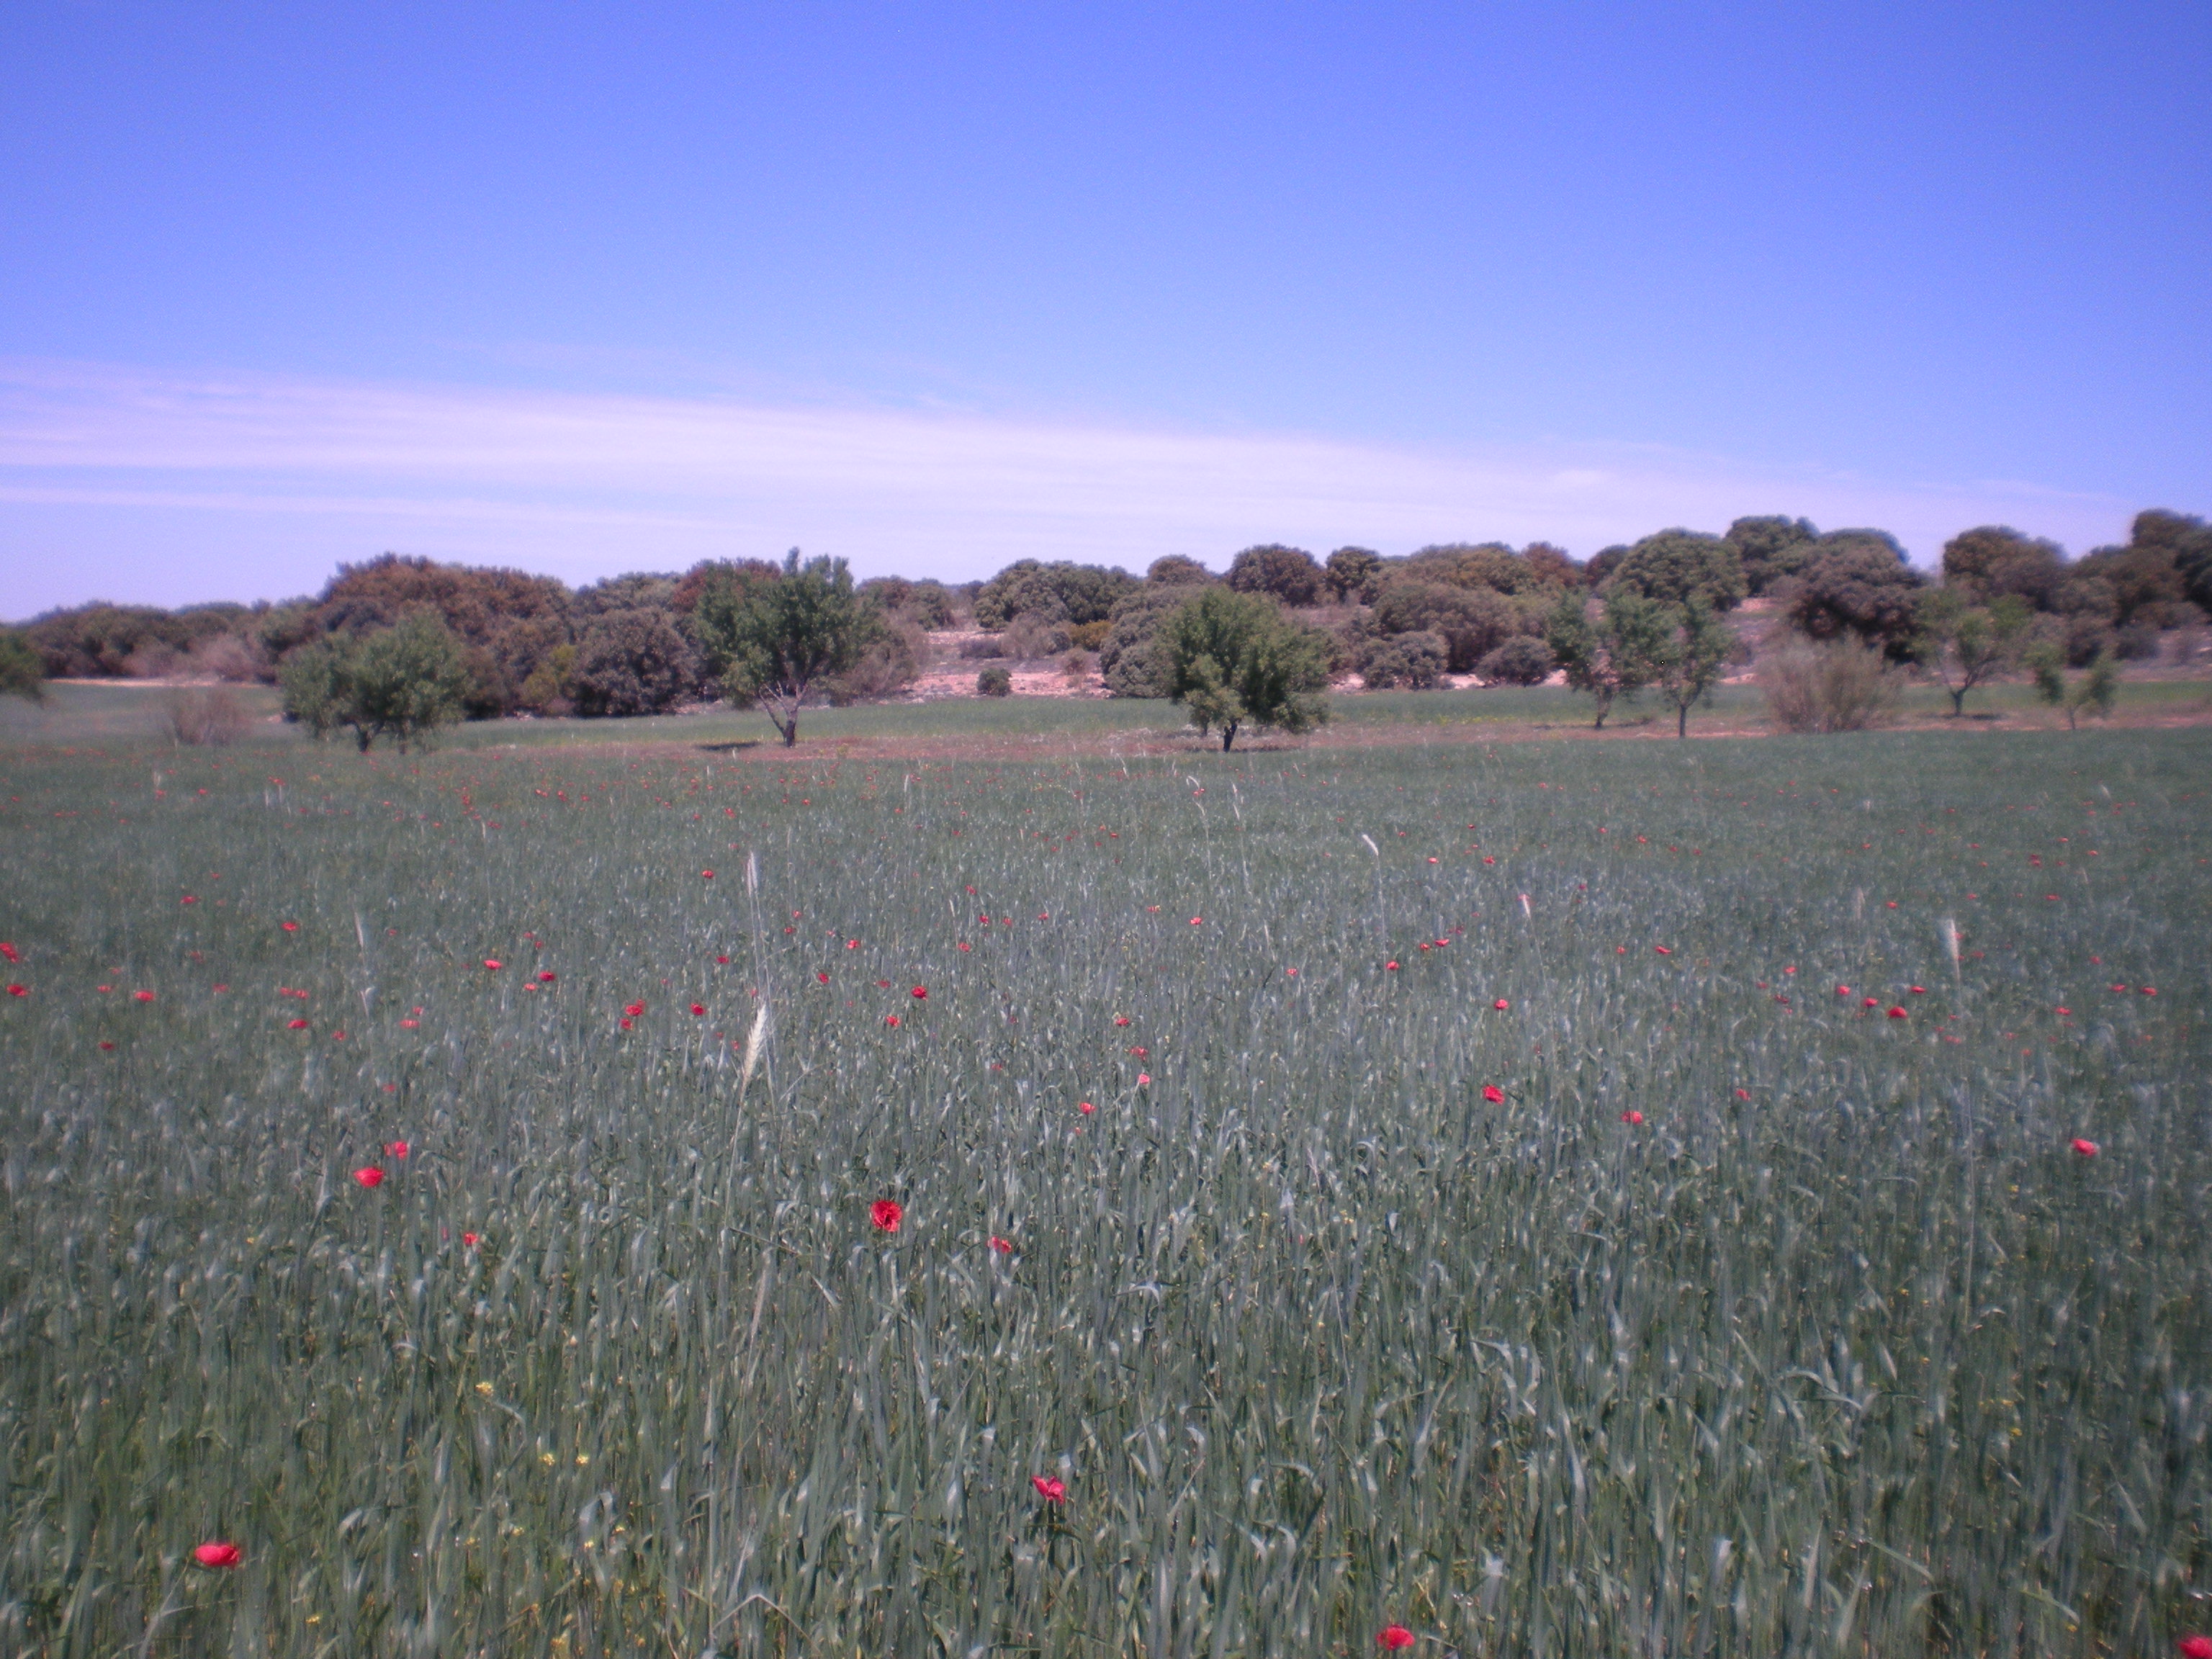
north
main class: Cropland
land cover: Common wheat
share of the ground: > 75 %
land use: Agriculture (excluding fallow land and kitchen gardens)
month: May
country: ES
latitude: 38.9895
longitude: -3.0449
